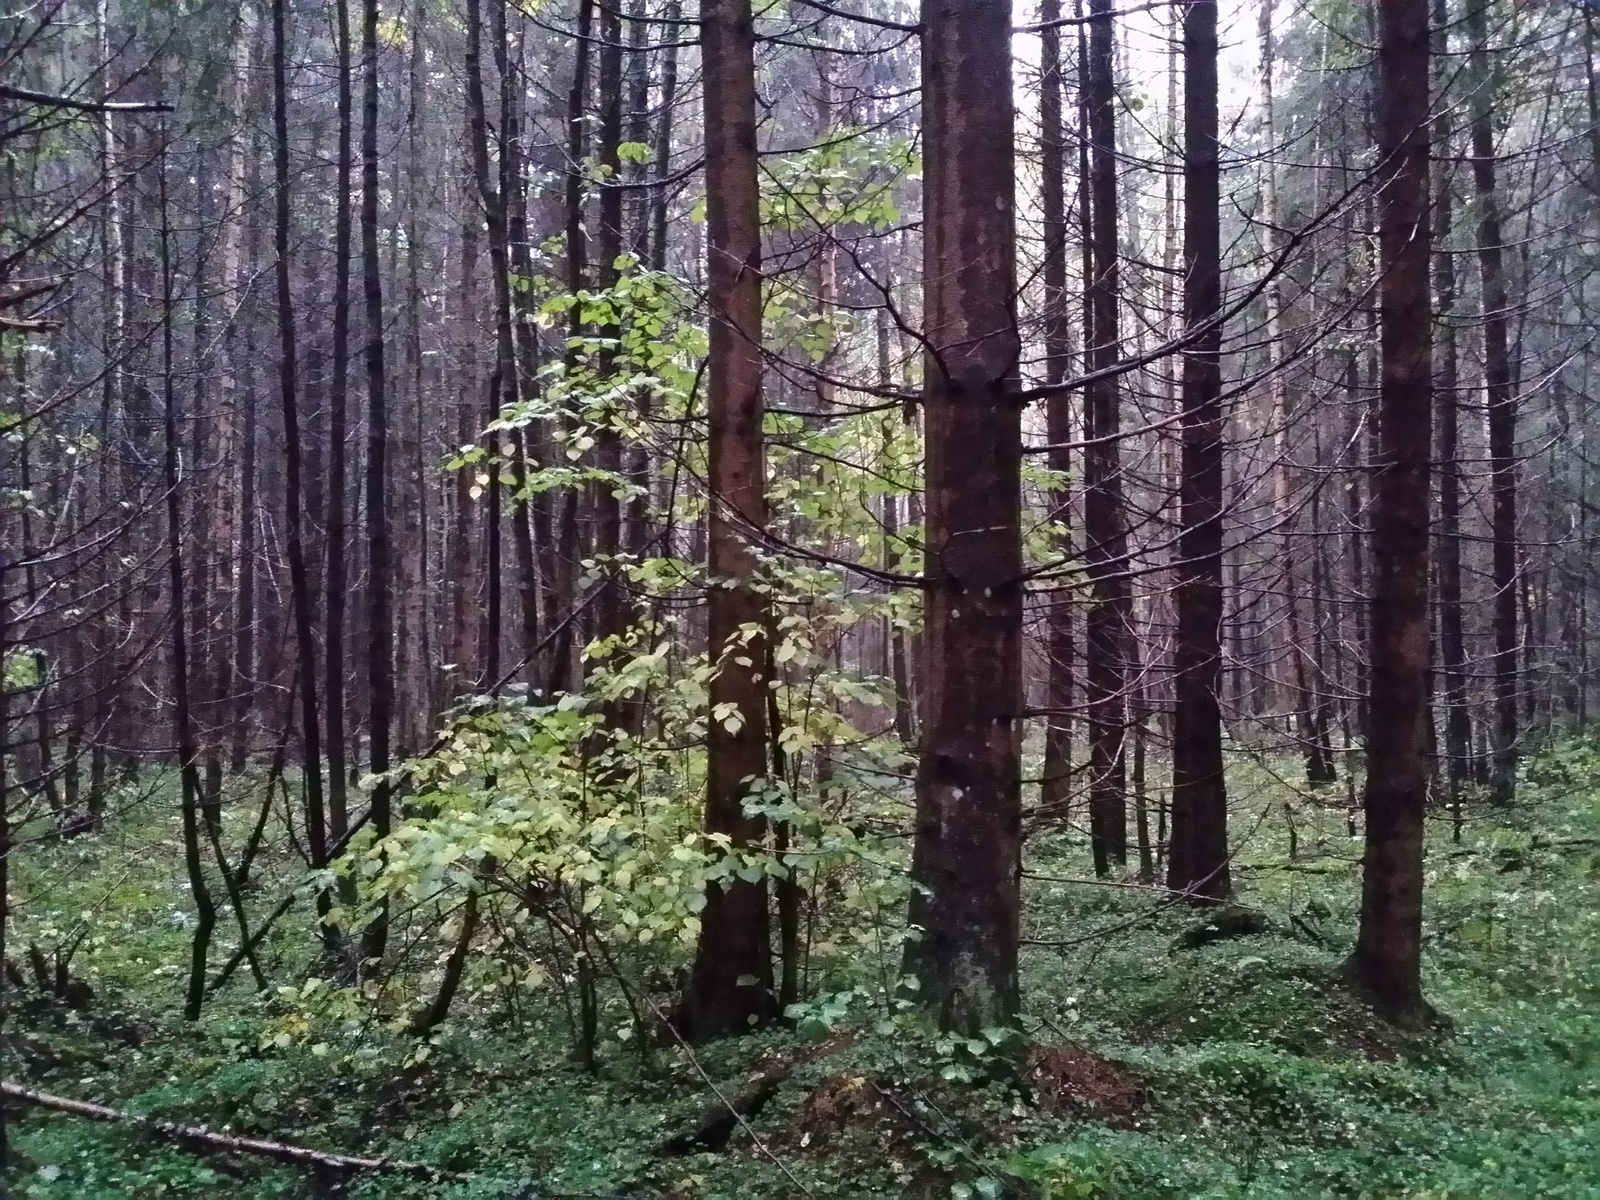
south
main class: Woodland
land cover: Spruce dominated coniferous woodland
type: hemiboreal forest and nemoral coniferous forest and mixed broadleaved-coniferous forest
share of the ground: > 75 %
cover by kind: coniferous forest trees 75 %, broadleaved forest trees 15 %, herbaceous plants 5 %, lichens and mosses 5 %
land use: Forestry
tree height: > 5 m
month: September
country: LV
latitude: 57.4597
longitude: 27.3894
